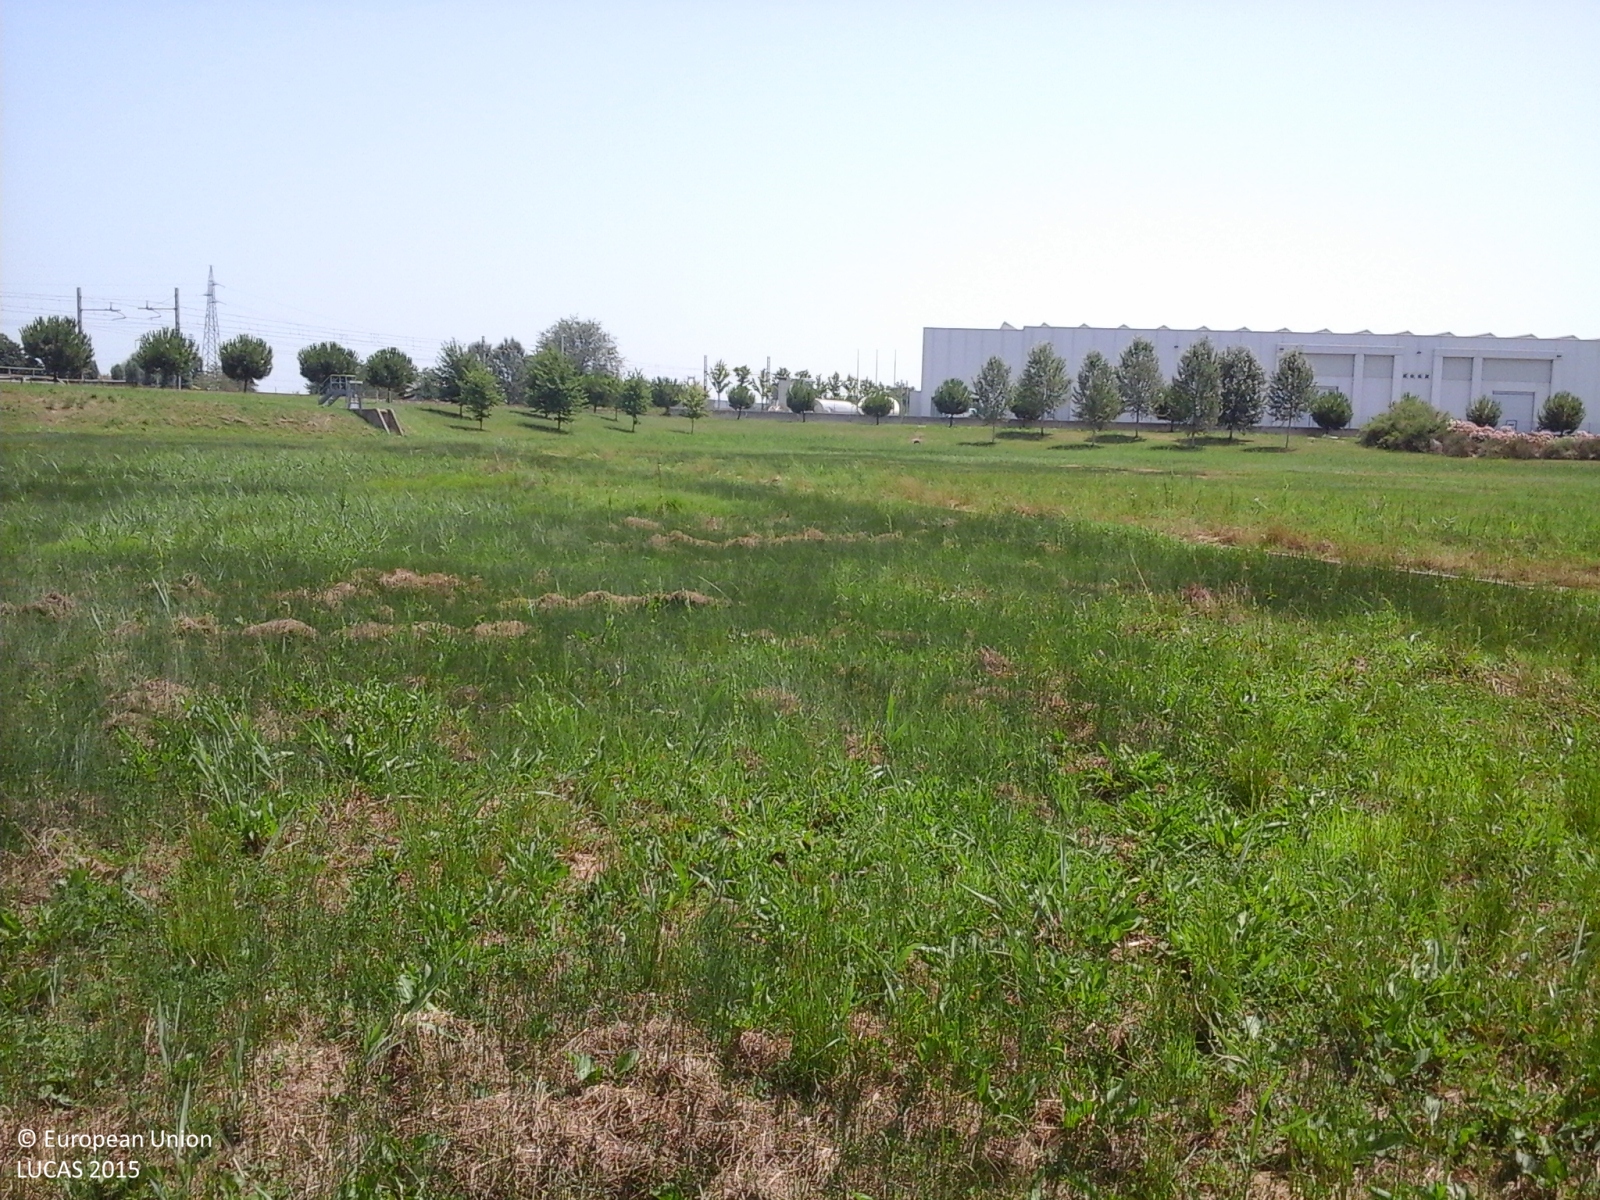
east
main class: Grassland
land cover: Spontaneously vegetated surfaces
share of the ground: > 75 %
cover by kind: herbaceous plants 100 %
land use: Fallow land
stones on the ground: < 10 %
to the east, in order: Spontaneously vegetated surfaces; Other structural elements; Spontaneously vegetated surfaces; Ditches and canals; Spontaneously vegetated surfaces; Lines of trees; Artificial constructions in urban areas; Grass margins; Ditches and canals
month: July
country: IT
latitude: 44.1073
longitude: 12.3559
